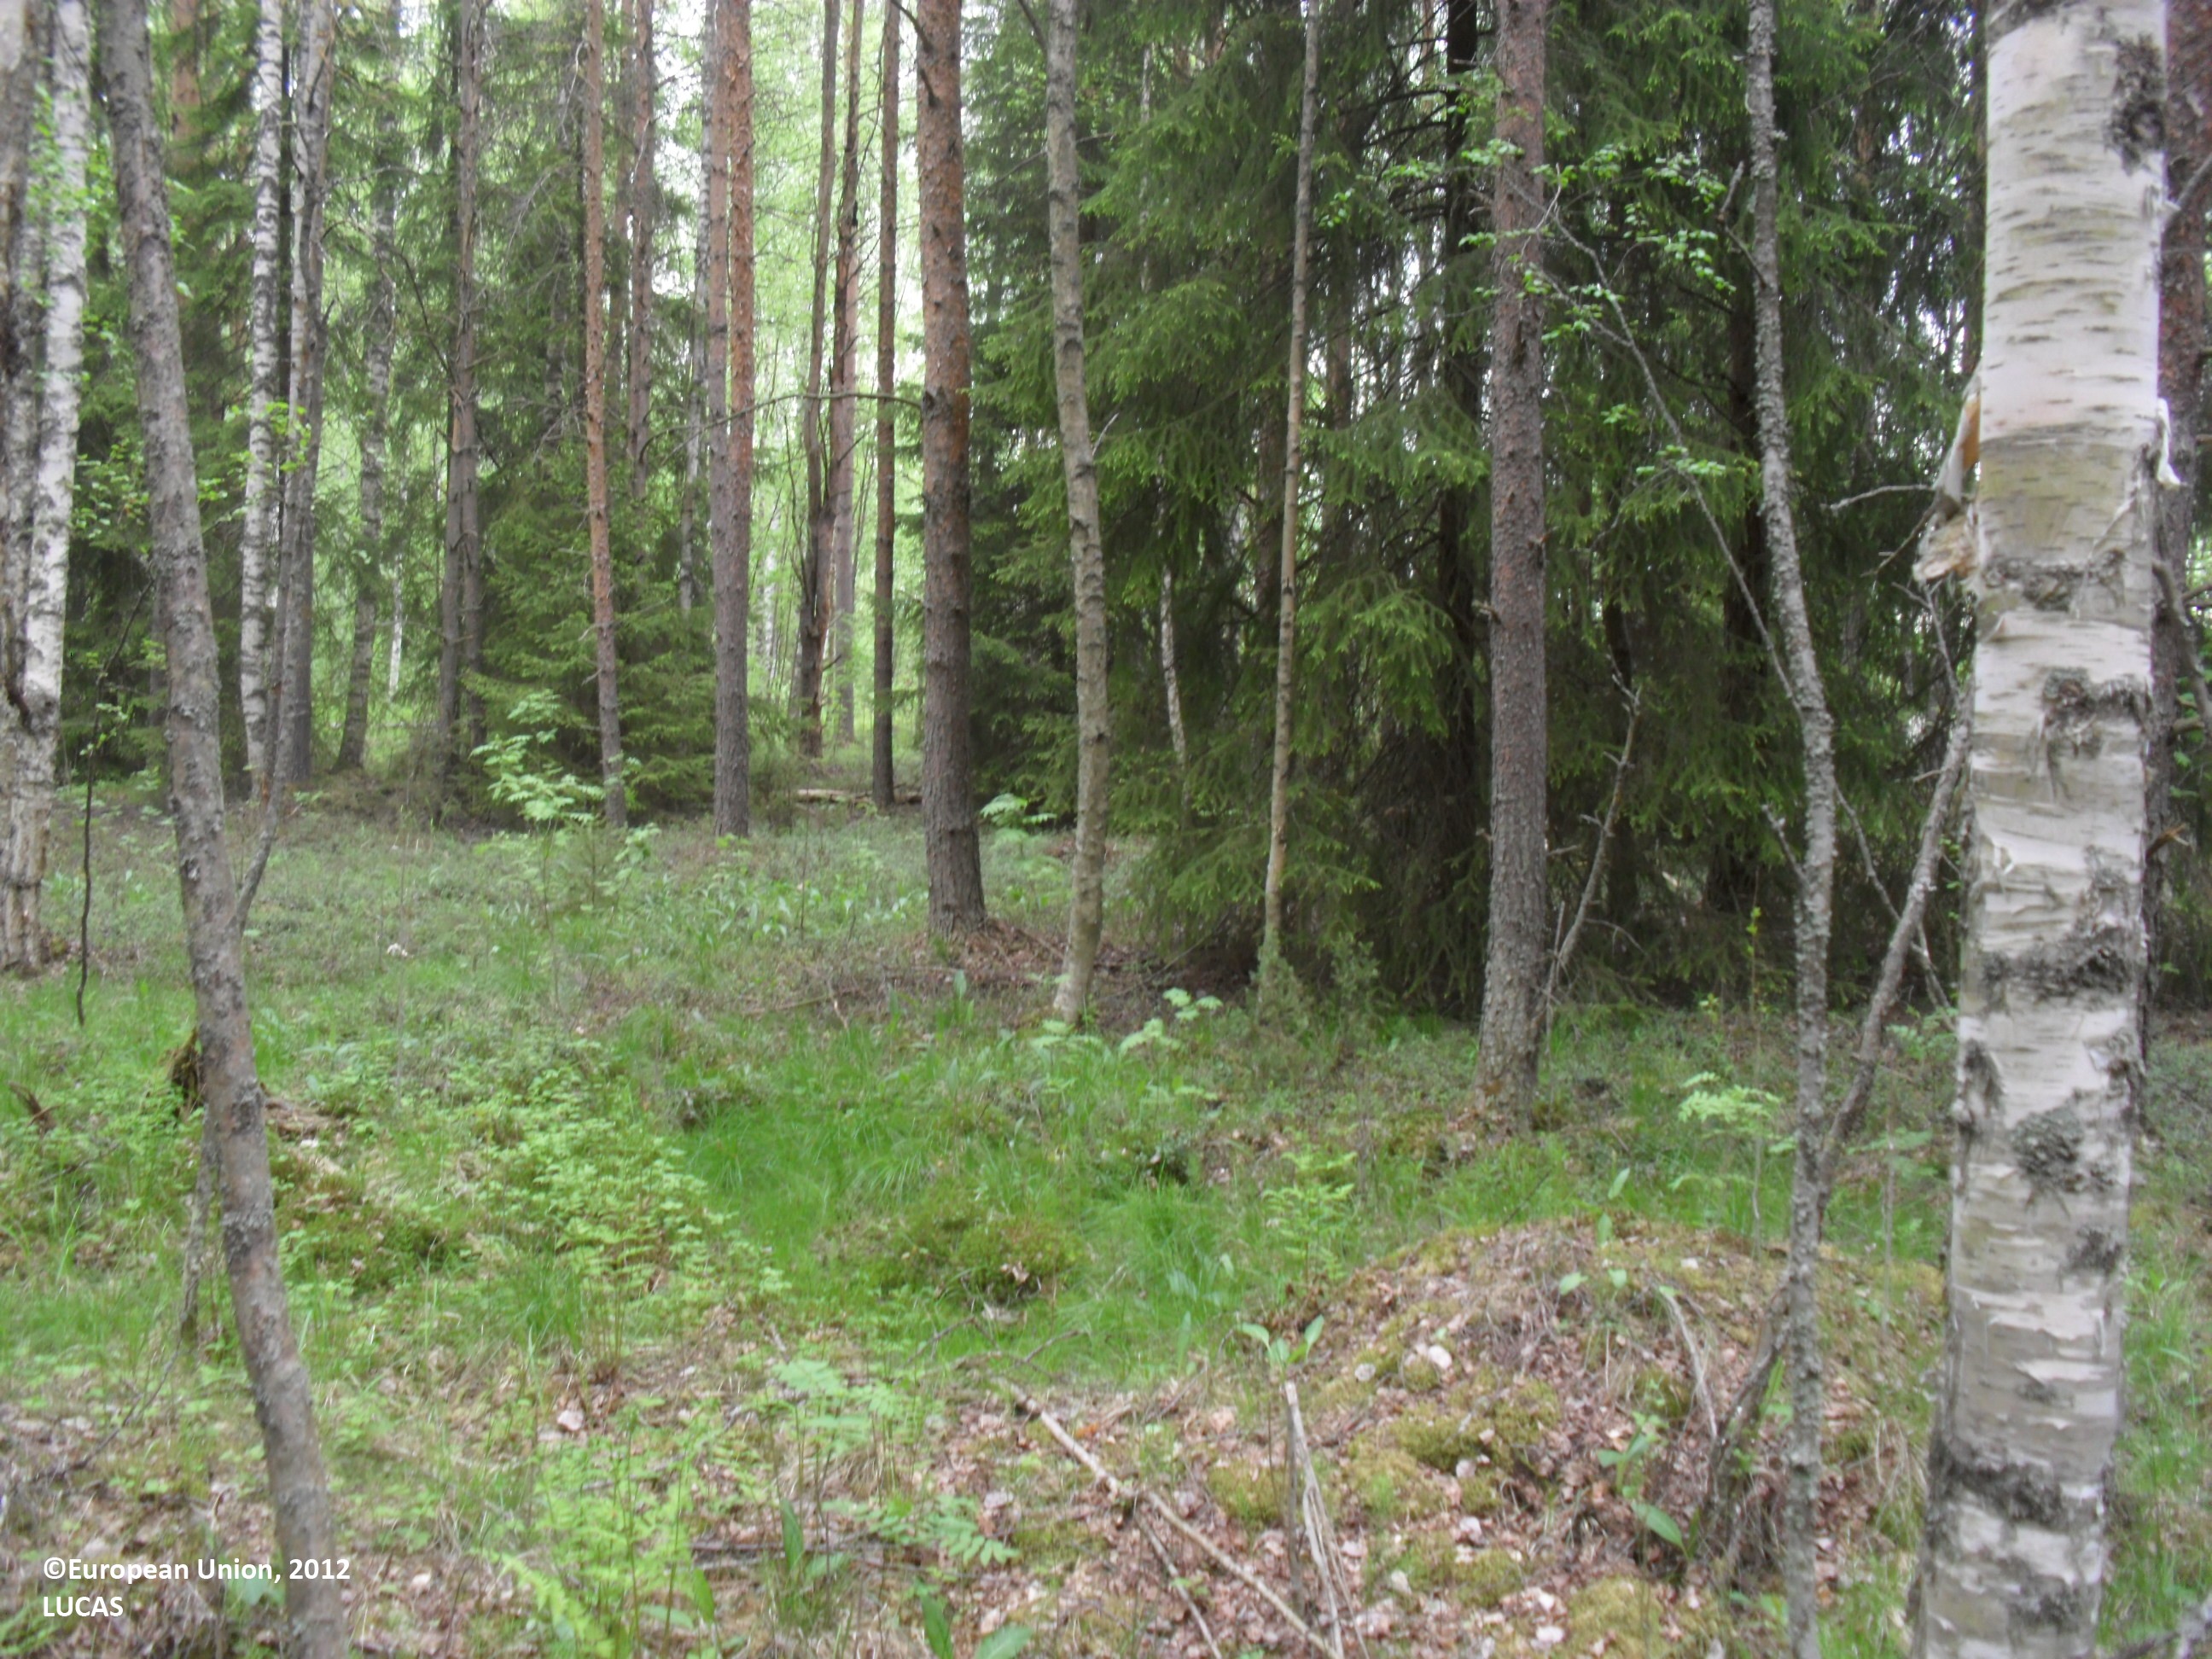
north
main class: Woodland
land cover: Other mixed woodland
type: boreal forest
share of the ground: 50 - 75 %
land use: Forestry
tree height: > 5 m
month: June
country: FI
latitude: 62.9112
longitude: 22.9517
